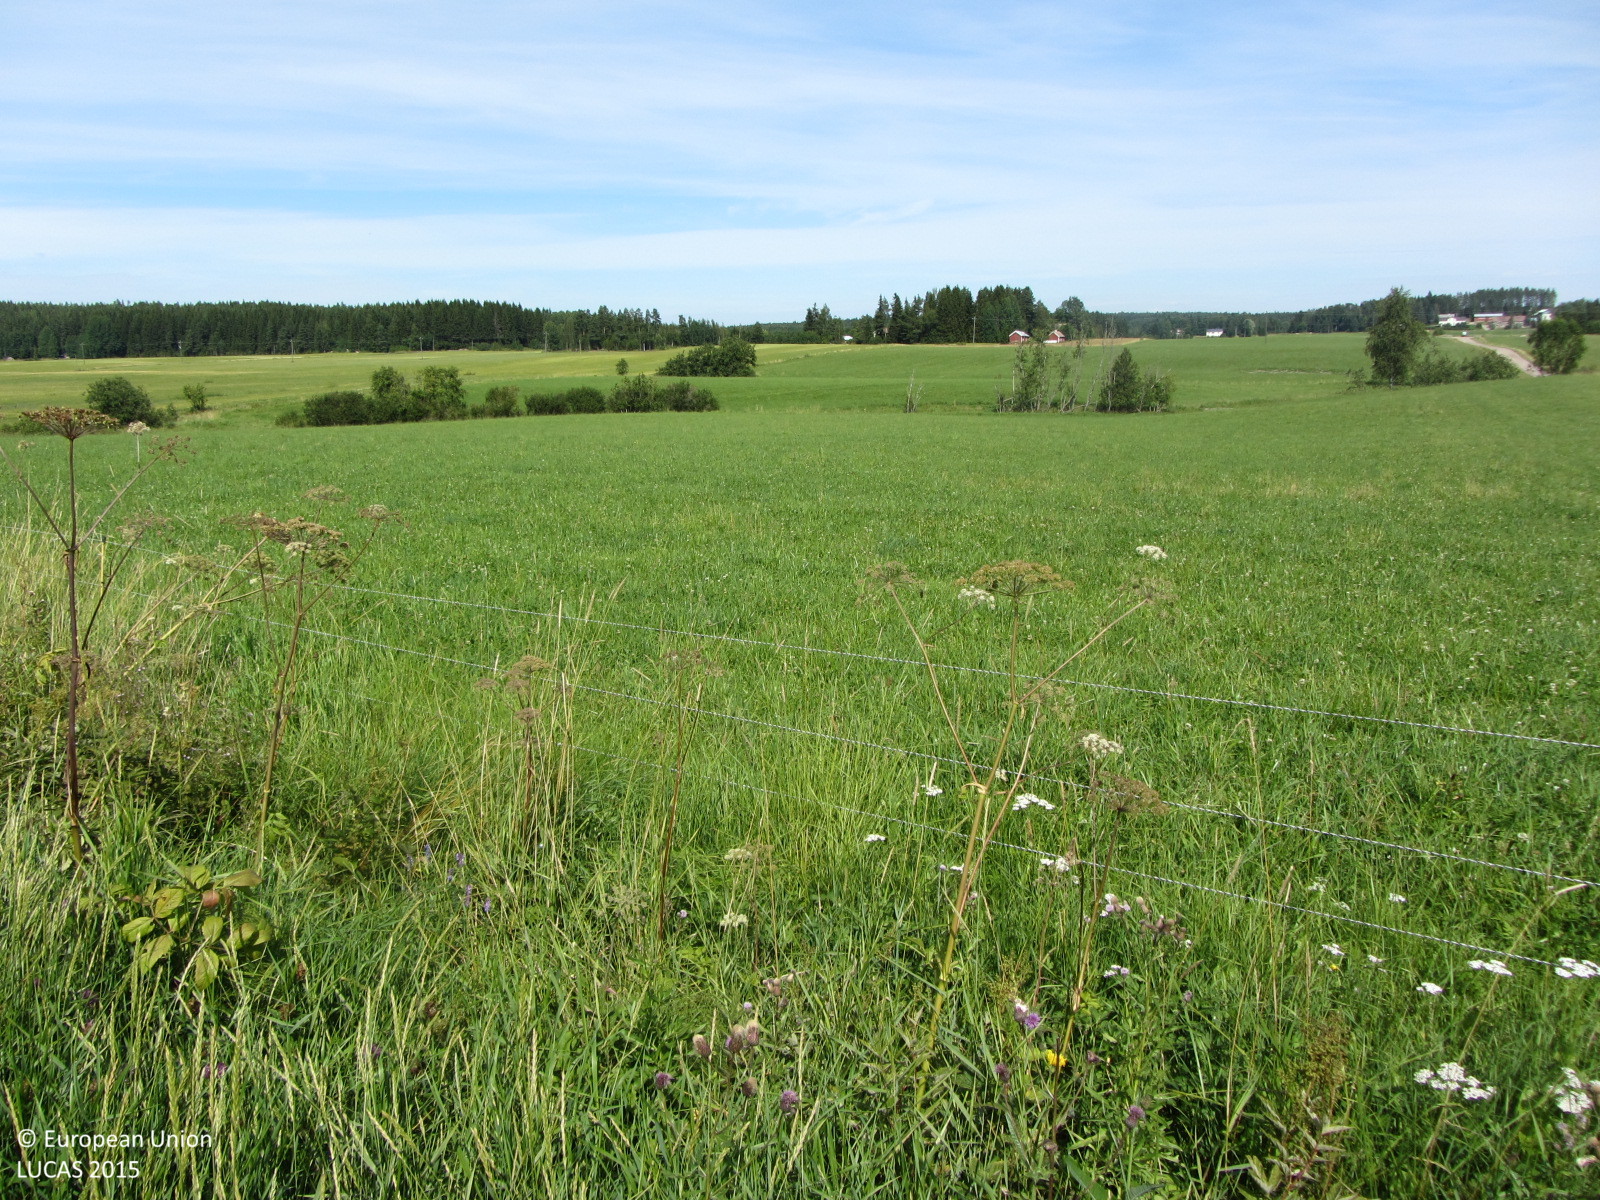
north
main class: Cropland
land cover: Barley
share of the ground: > 75 %
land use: Agriculture (excluding fallow land and kitchen gardens)
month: August
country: FI
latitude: 60.4657
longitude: 23.4530
